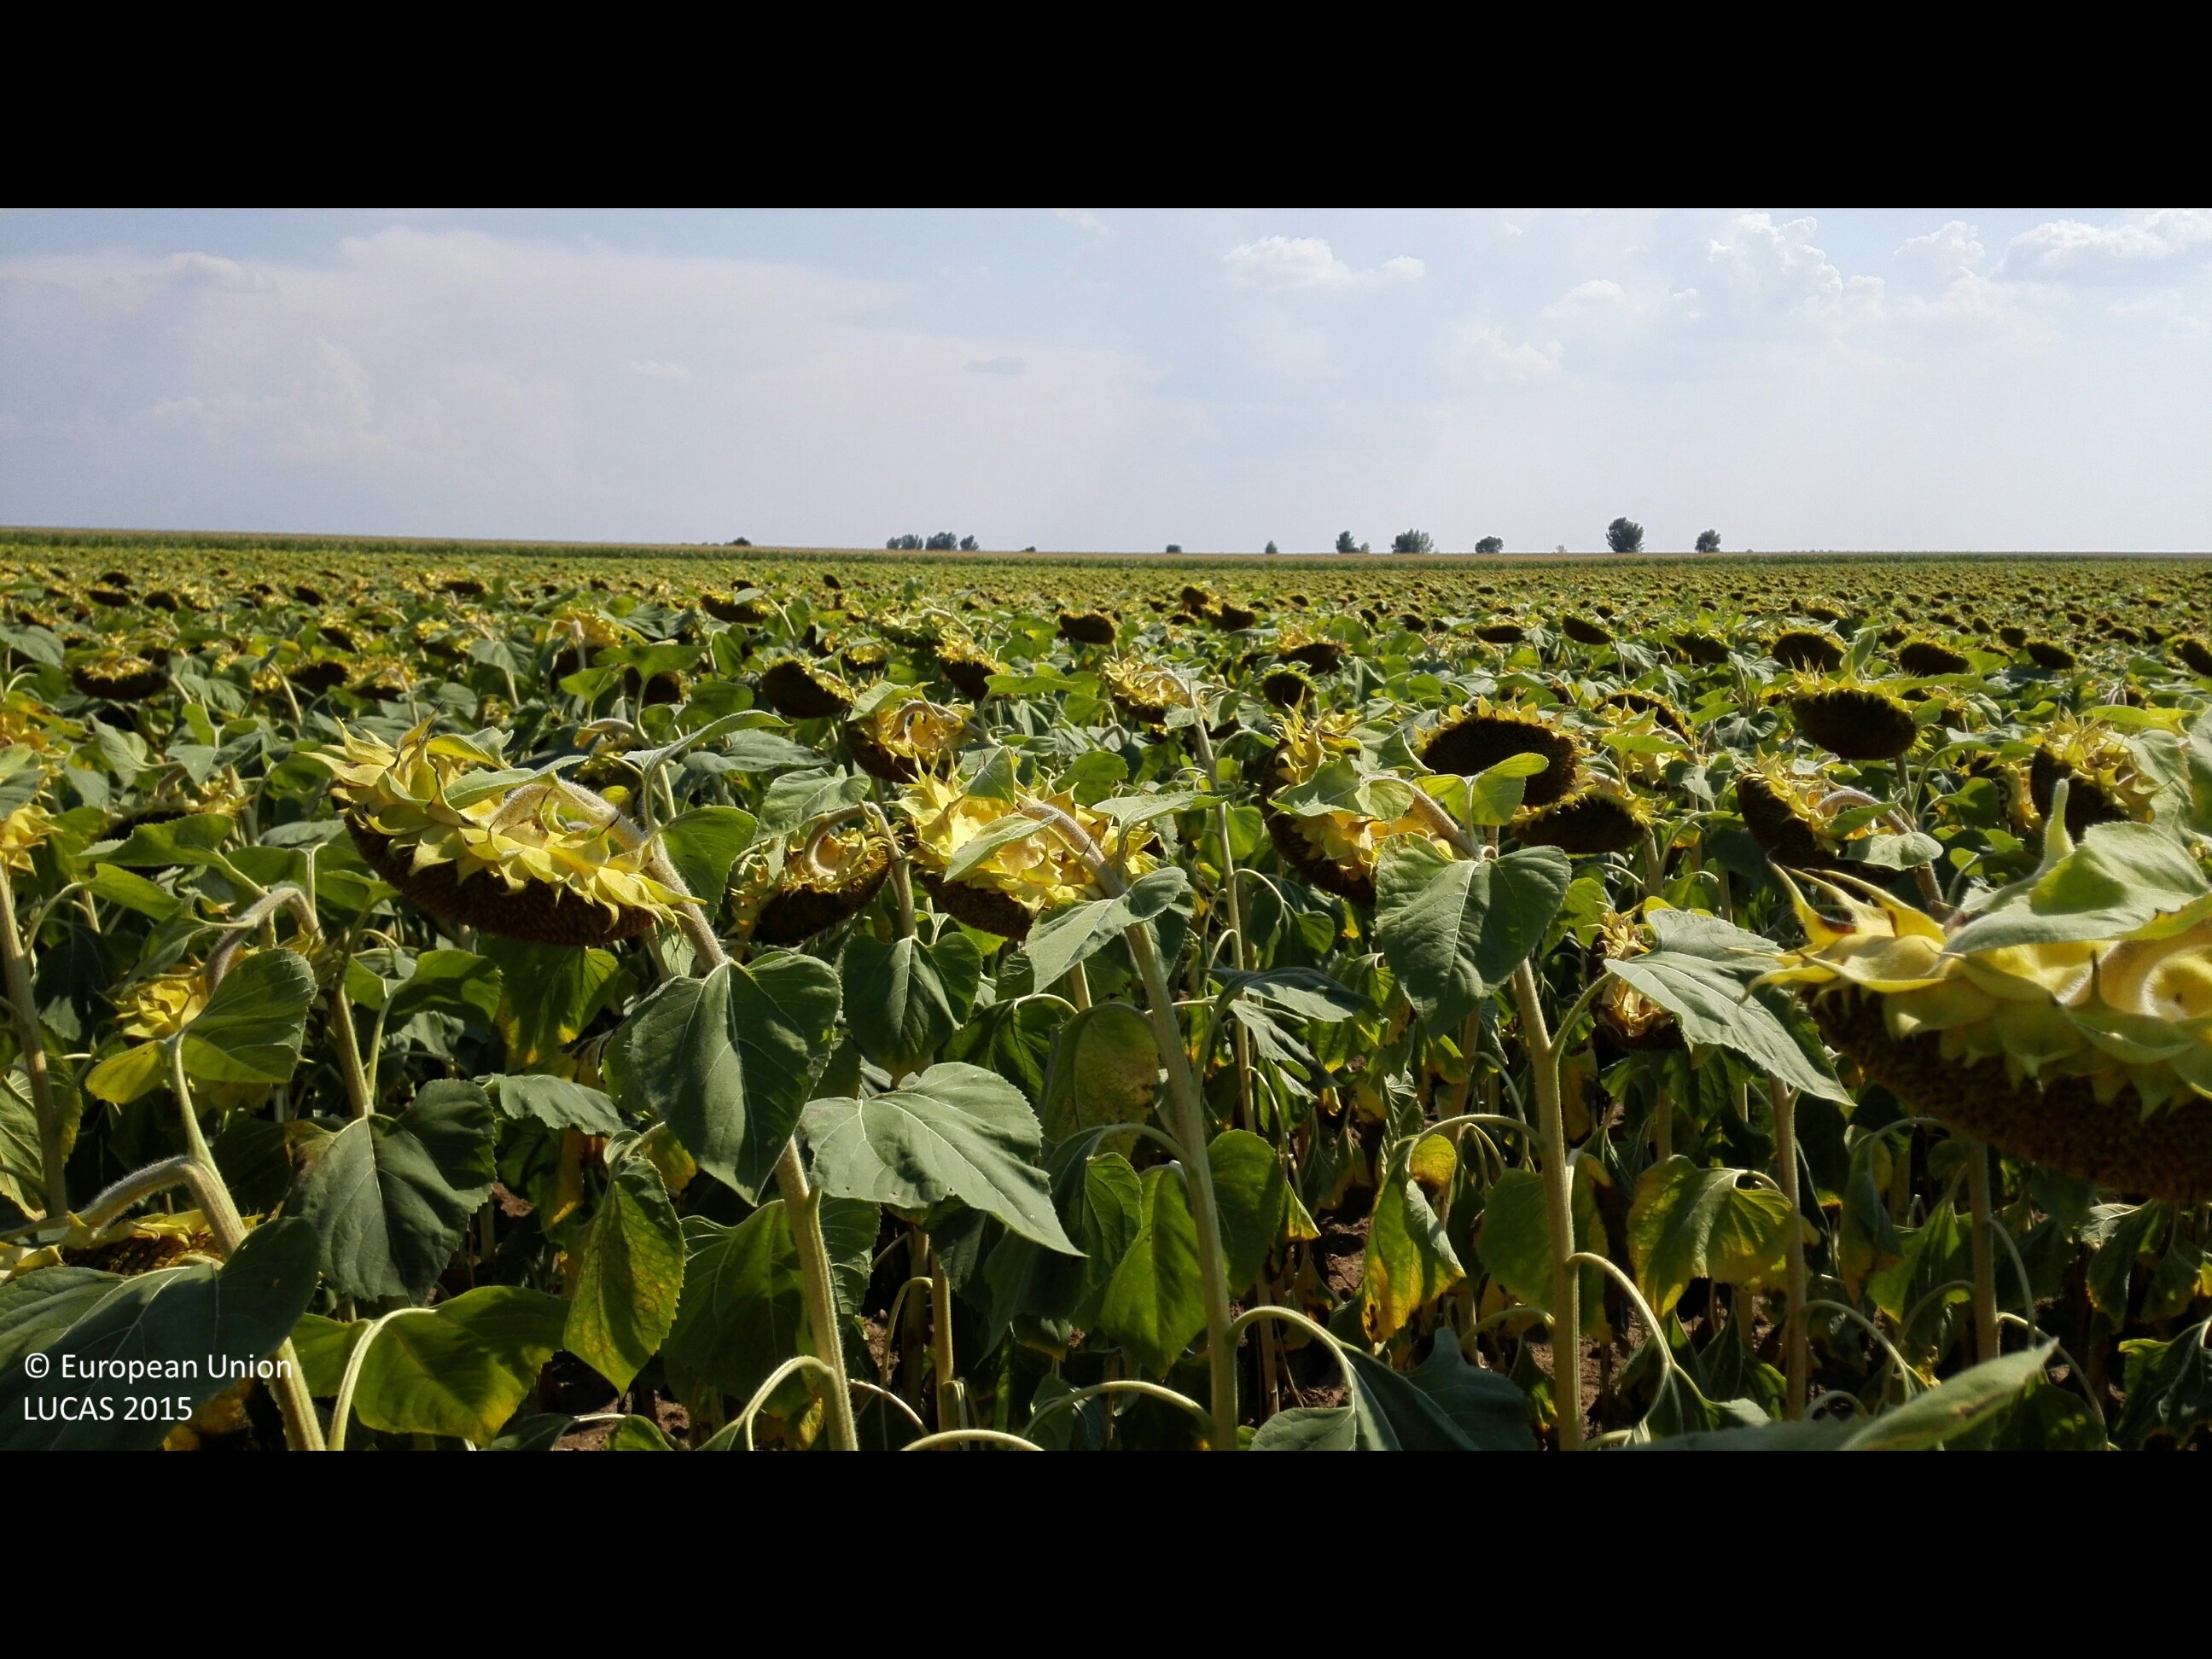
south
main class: Cropland
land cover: Sunflower
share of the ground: > 75 %
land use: Agriculture (excluding fallow land and kitchen gardens)
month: August
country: HU
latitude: 47.4355
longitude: 22.0225
